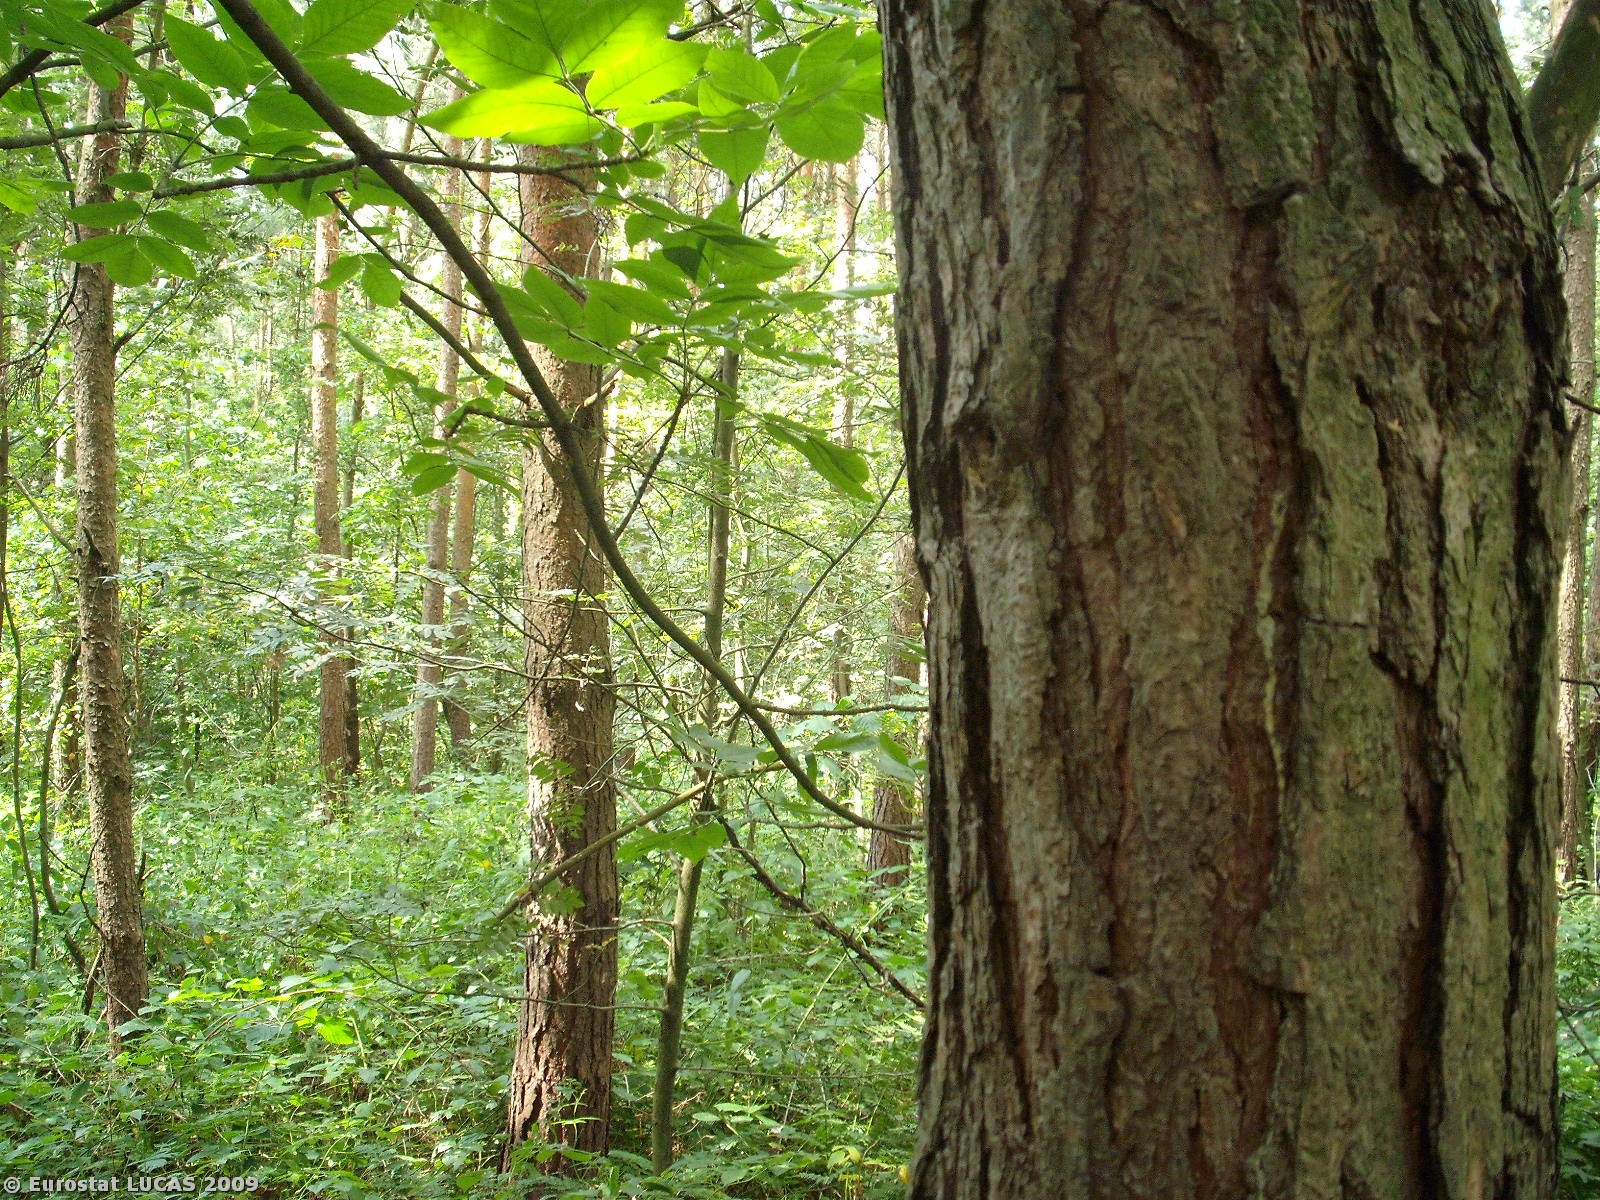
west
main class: Woodland
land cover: Coniferous woodland
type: hemiboreal forest and nemoral coniferous forest and mixed broadleaved-coniferous forest
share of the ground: > 75 %
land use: Forestry
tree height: > 5 m
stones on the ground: < 10 %
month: August
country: PL
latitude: 51.7700
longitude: 21.6023
